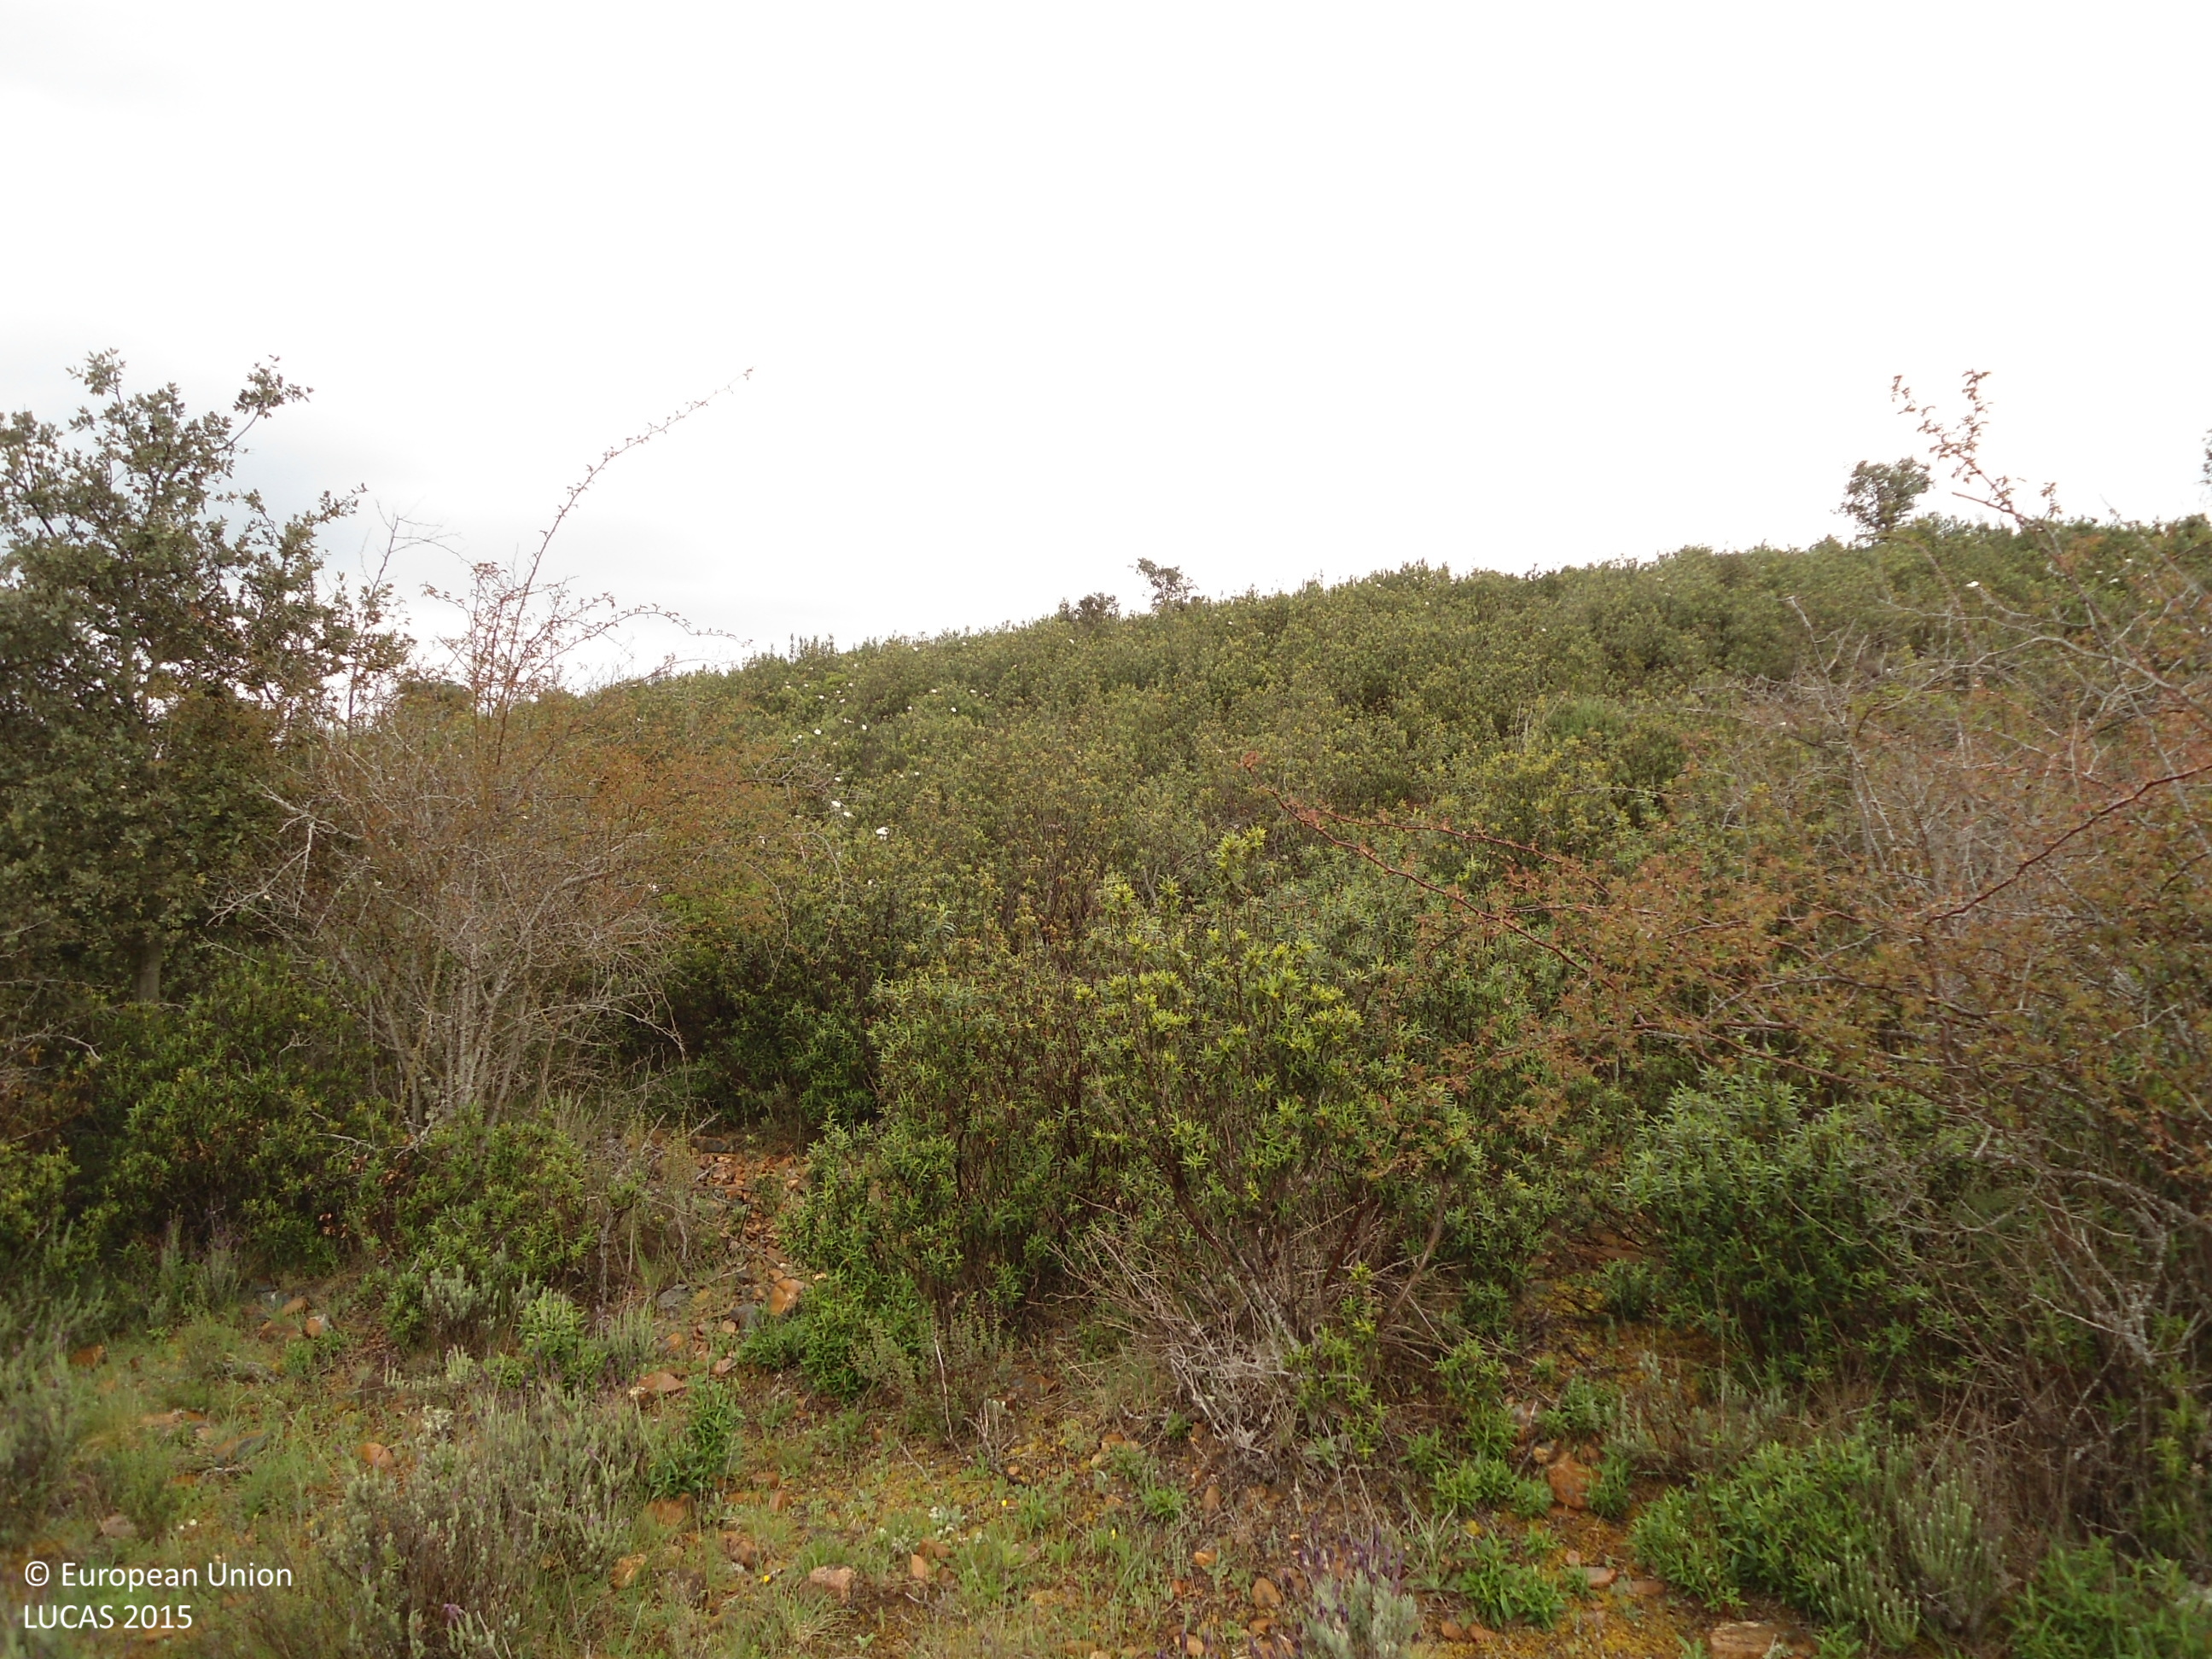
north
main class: Shrubland
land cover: Shrubland without tree cover
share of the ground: > 75 %
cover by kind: shrubs 80 %, herbaceous plants 20 %
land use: Agriculture (excluding fallow land and kitchen gardens)
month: April
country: ES
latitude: 41.7271
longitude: -5.8520
